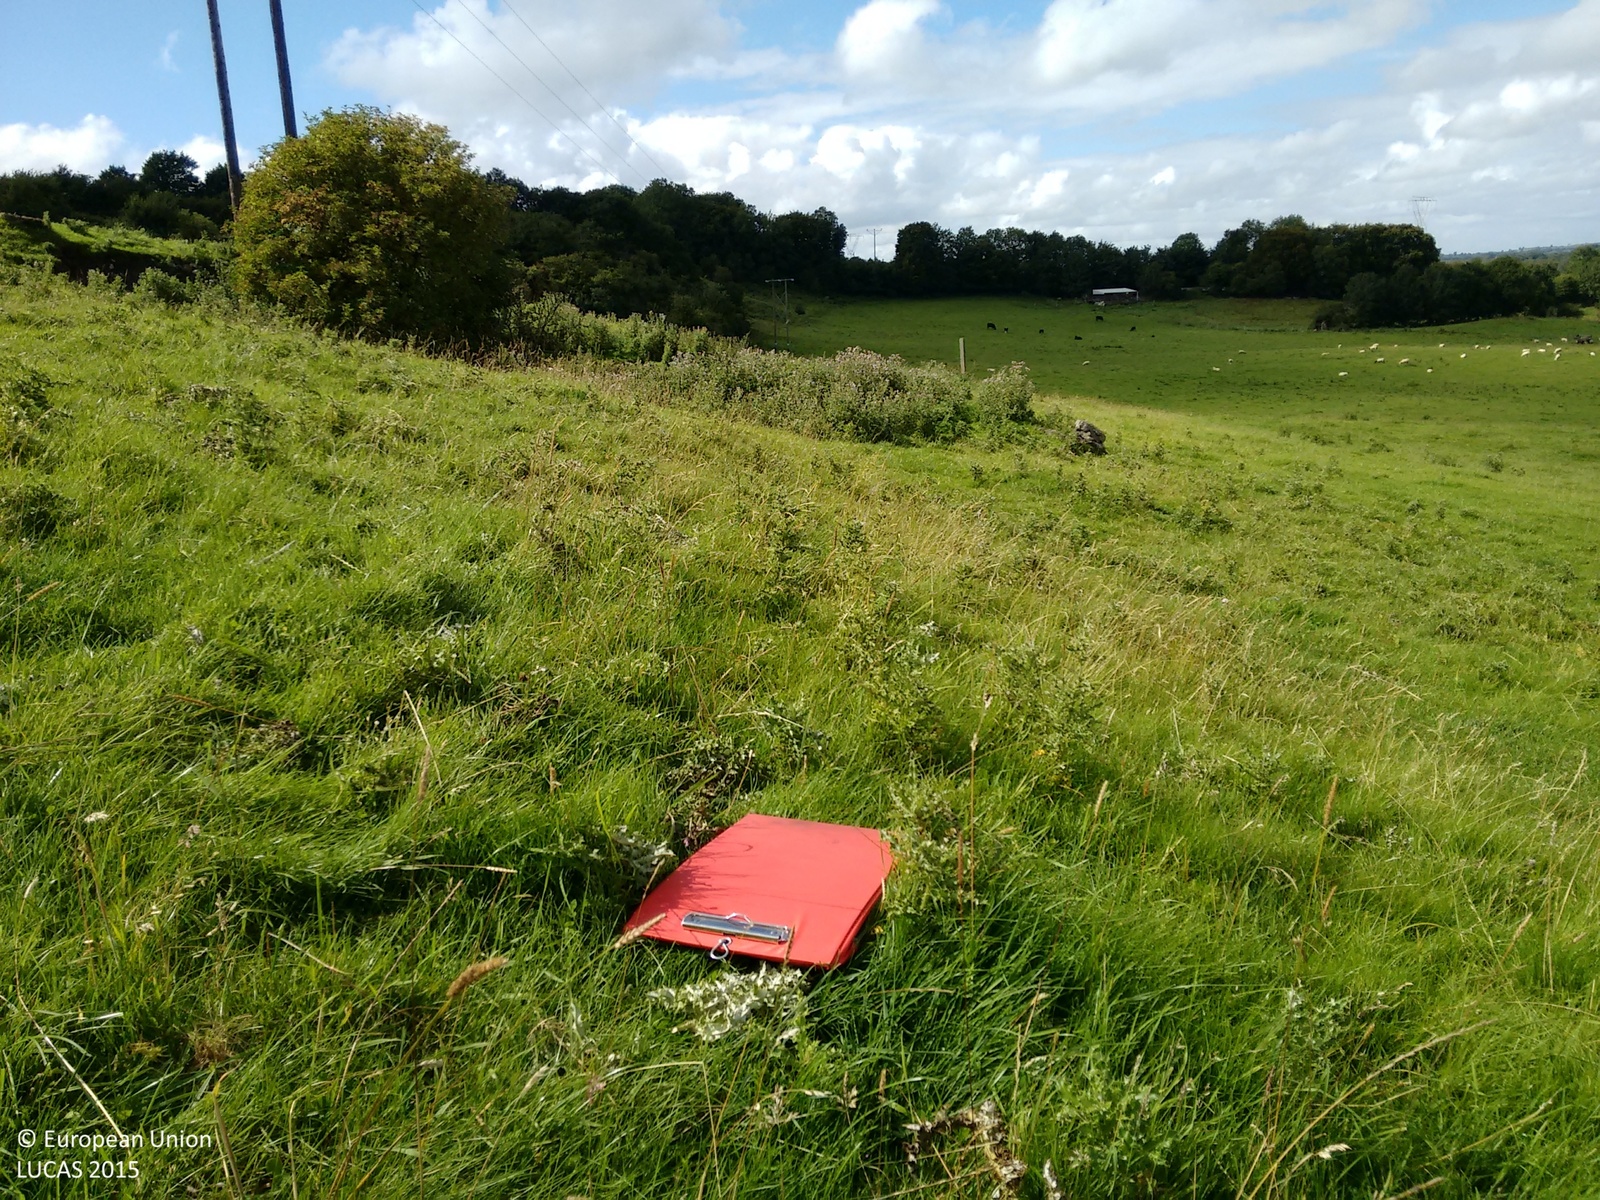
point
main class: Grassland
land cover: Grassland without tree/shrub cover
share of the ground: > 75 %
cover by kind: herbaceous plants 100 %
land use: Agriculture (excluding fallow land and kitchen gardens)
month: August
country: IE
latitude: 53.3507
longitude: -7.6030
